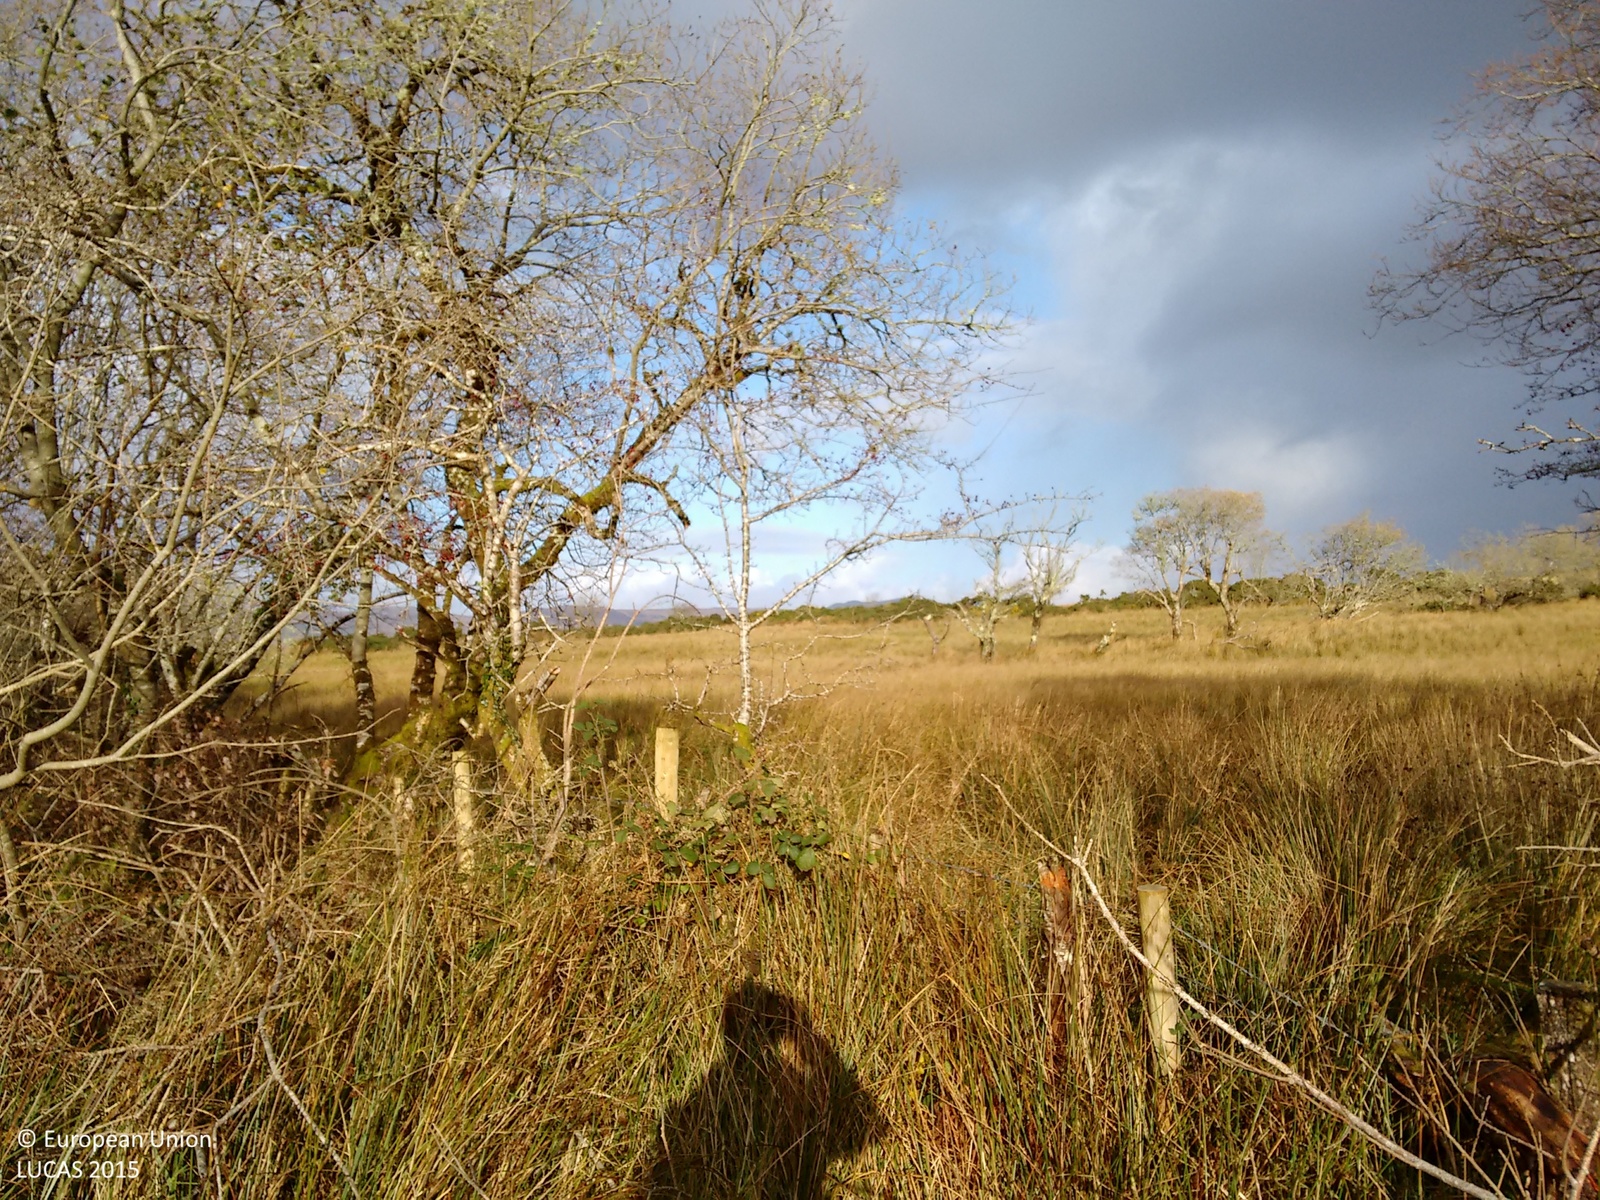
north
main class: Grassland
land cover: Grassland without tree/shrub cover
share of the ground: > 75 %
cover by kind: herbaceous plants 100 %
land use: Agriculture (excluding fallow land and kitchen gardens)
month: November
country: IE
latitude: 54.6681
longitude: -8.1804
